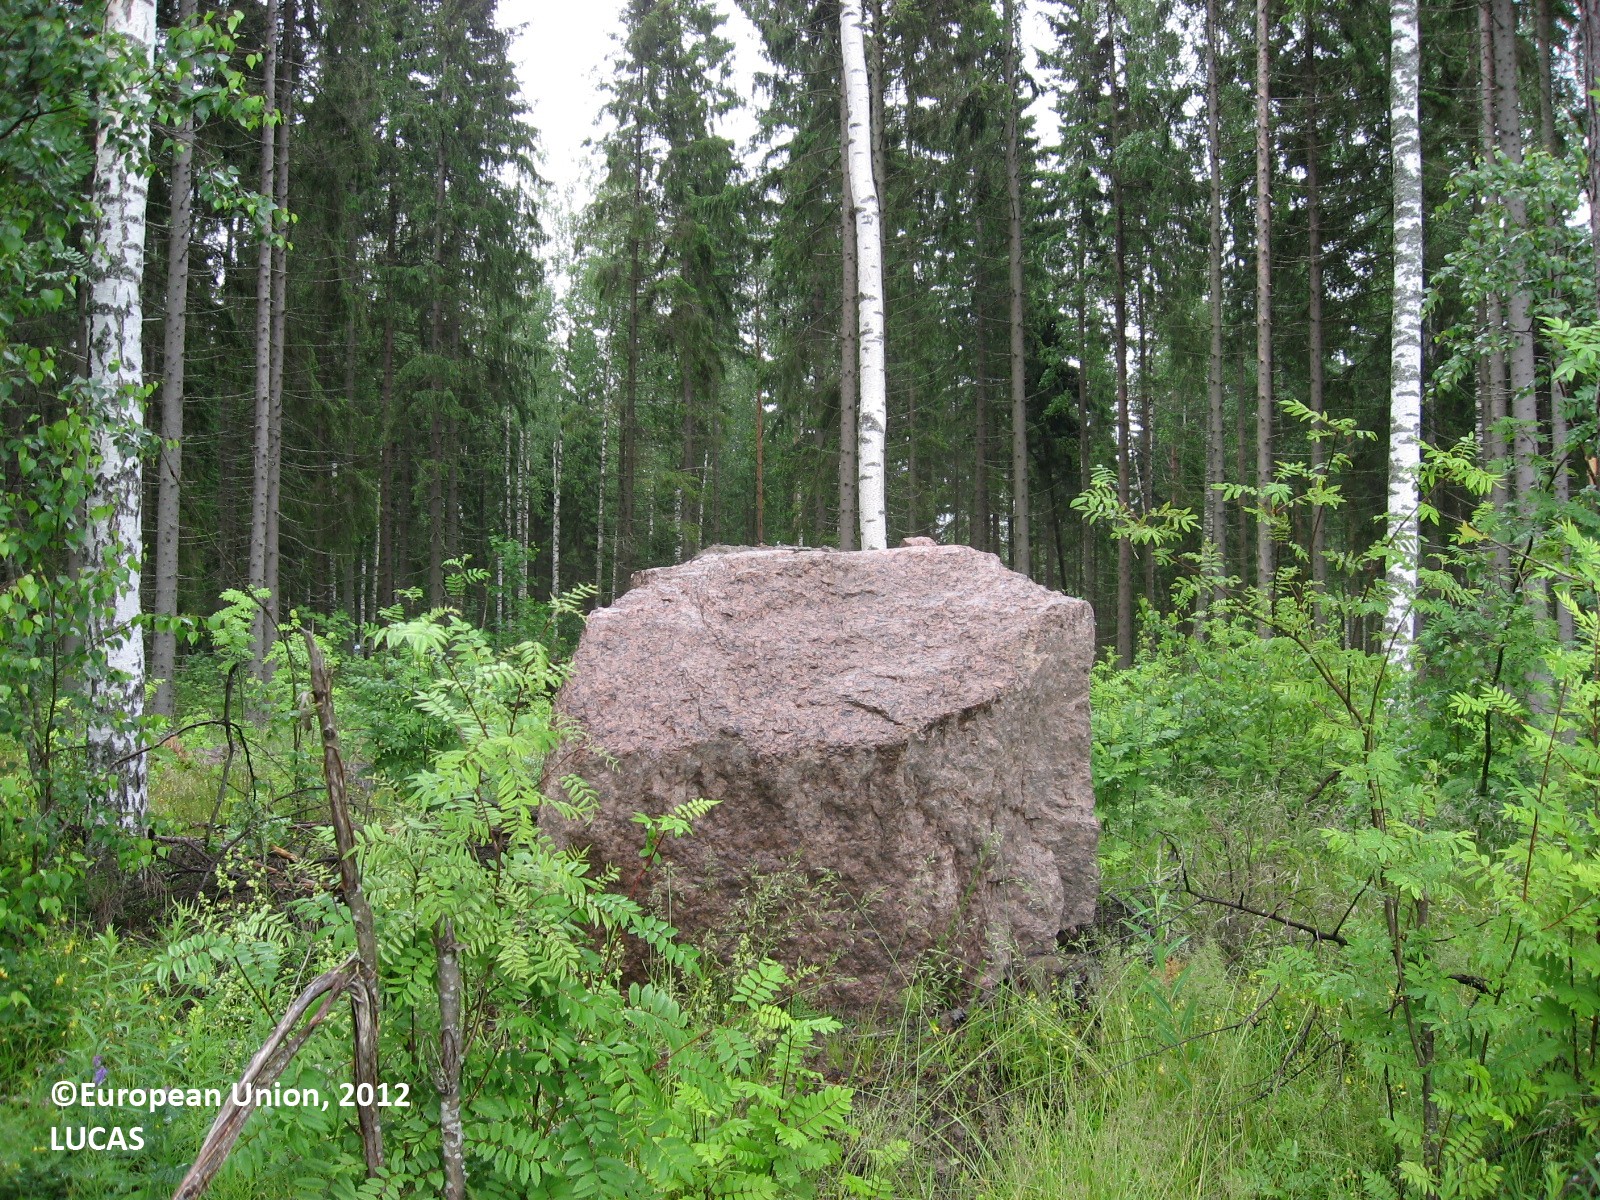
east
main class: Cropland
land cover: Common wheat
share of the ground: > 75 %
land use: Agriculture (excluding fallow land and kitchen gardens)
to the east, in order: Common wheat; Grass margins; Ditches and canals; Spruce dominated mixed woodland; Ditches and canals; Spruce dominated mixed woodland; Ditches and canals; Spruce dominated mixed woodland
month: June
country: FI
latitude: 60.5337
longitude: 26.1282
